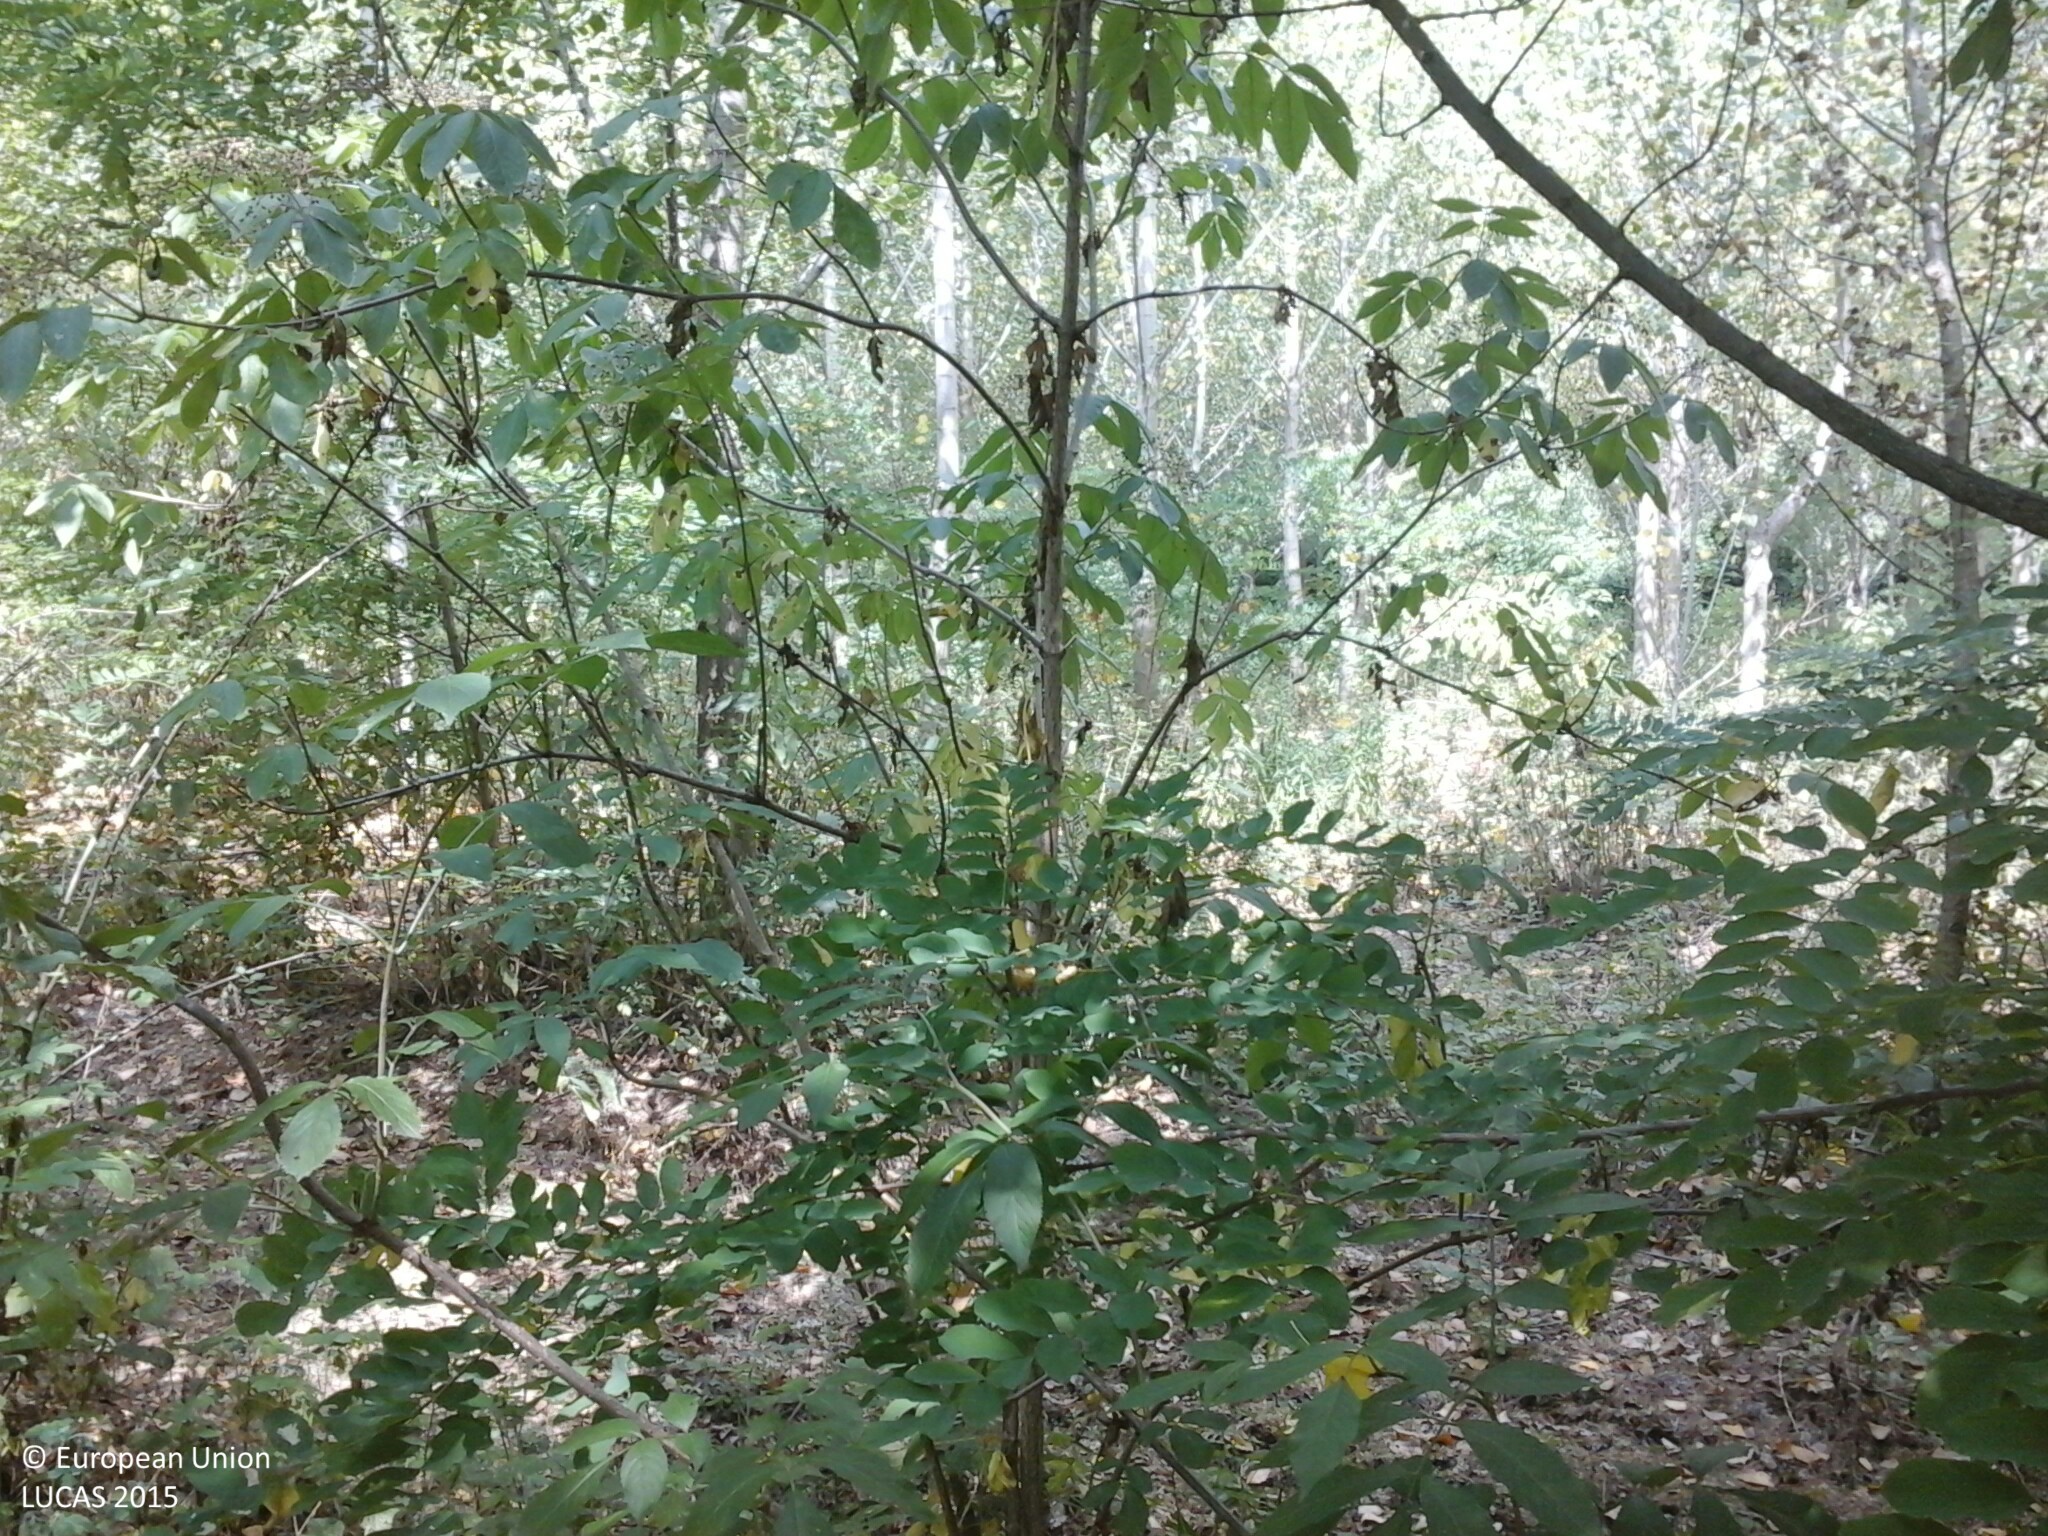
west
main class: Woodland
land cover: Broadleaved woodland
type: floodplain forest
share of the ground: > 75 %
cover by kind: broadleaved forest trees 100 %
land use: Forestry
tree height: > 5 m
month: July
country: HU
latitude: 48.3923
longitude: 22.2526
